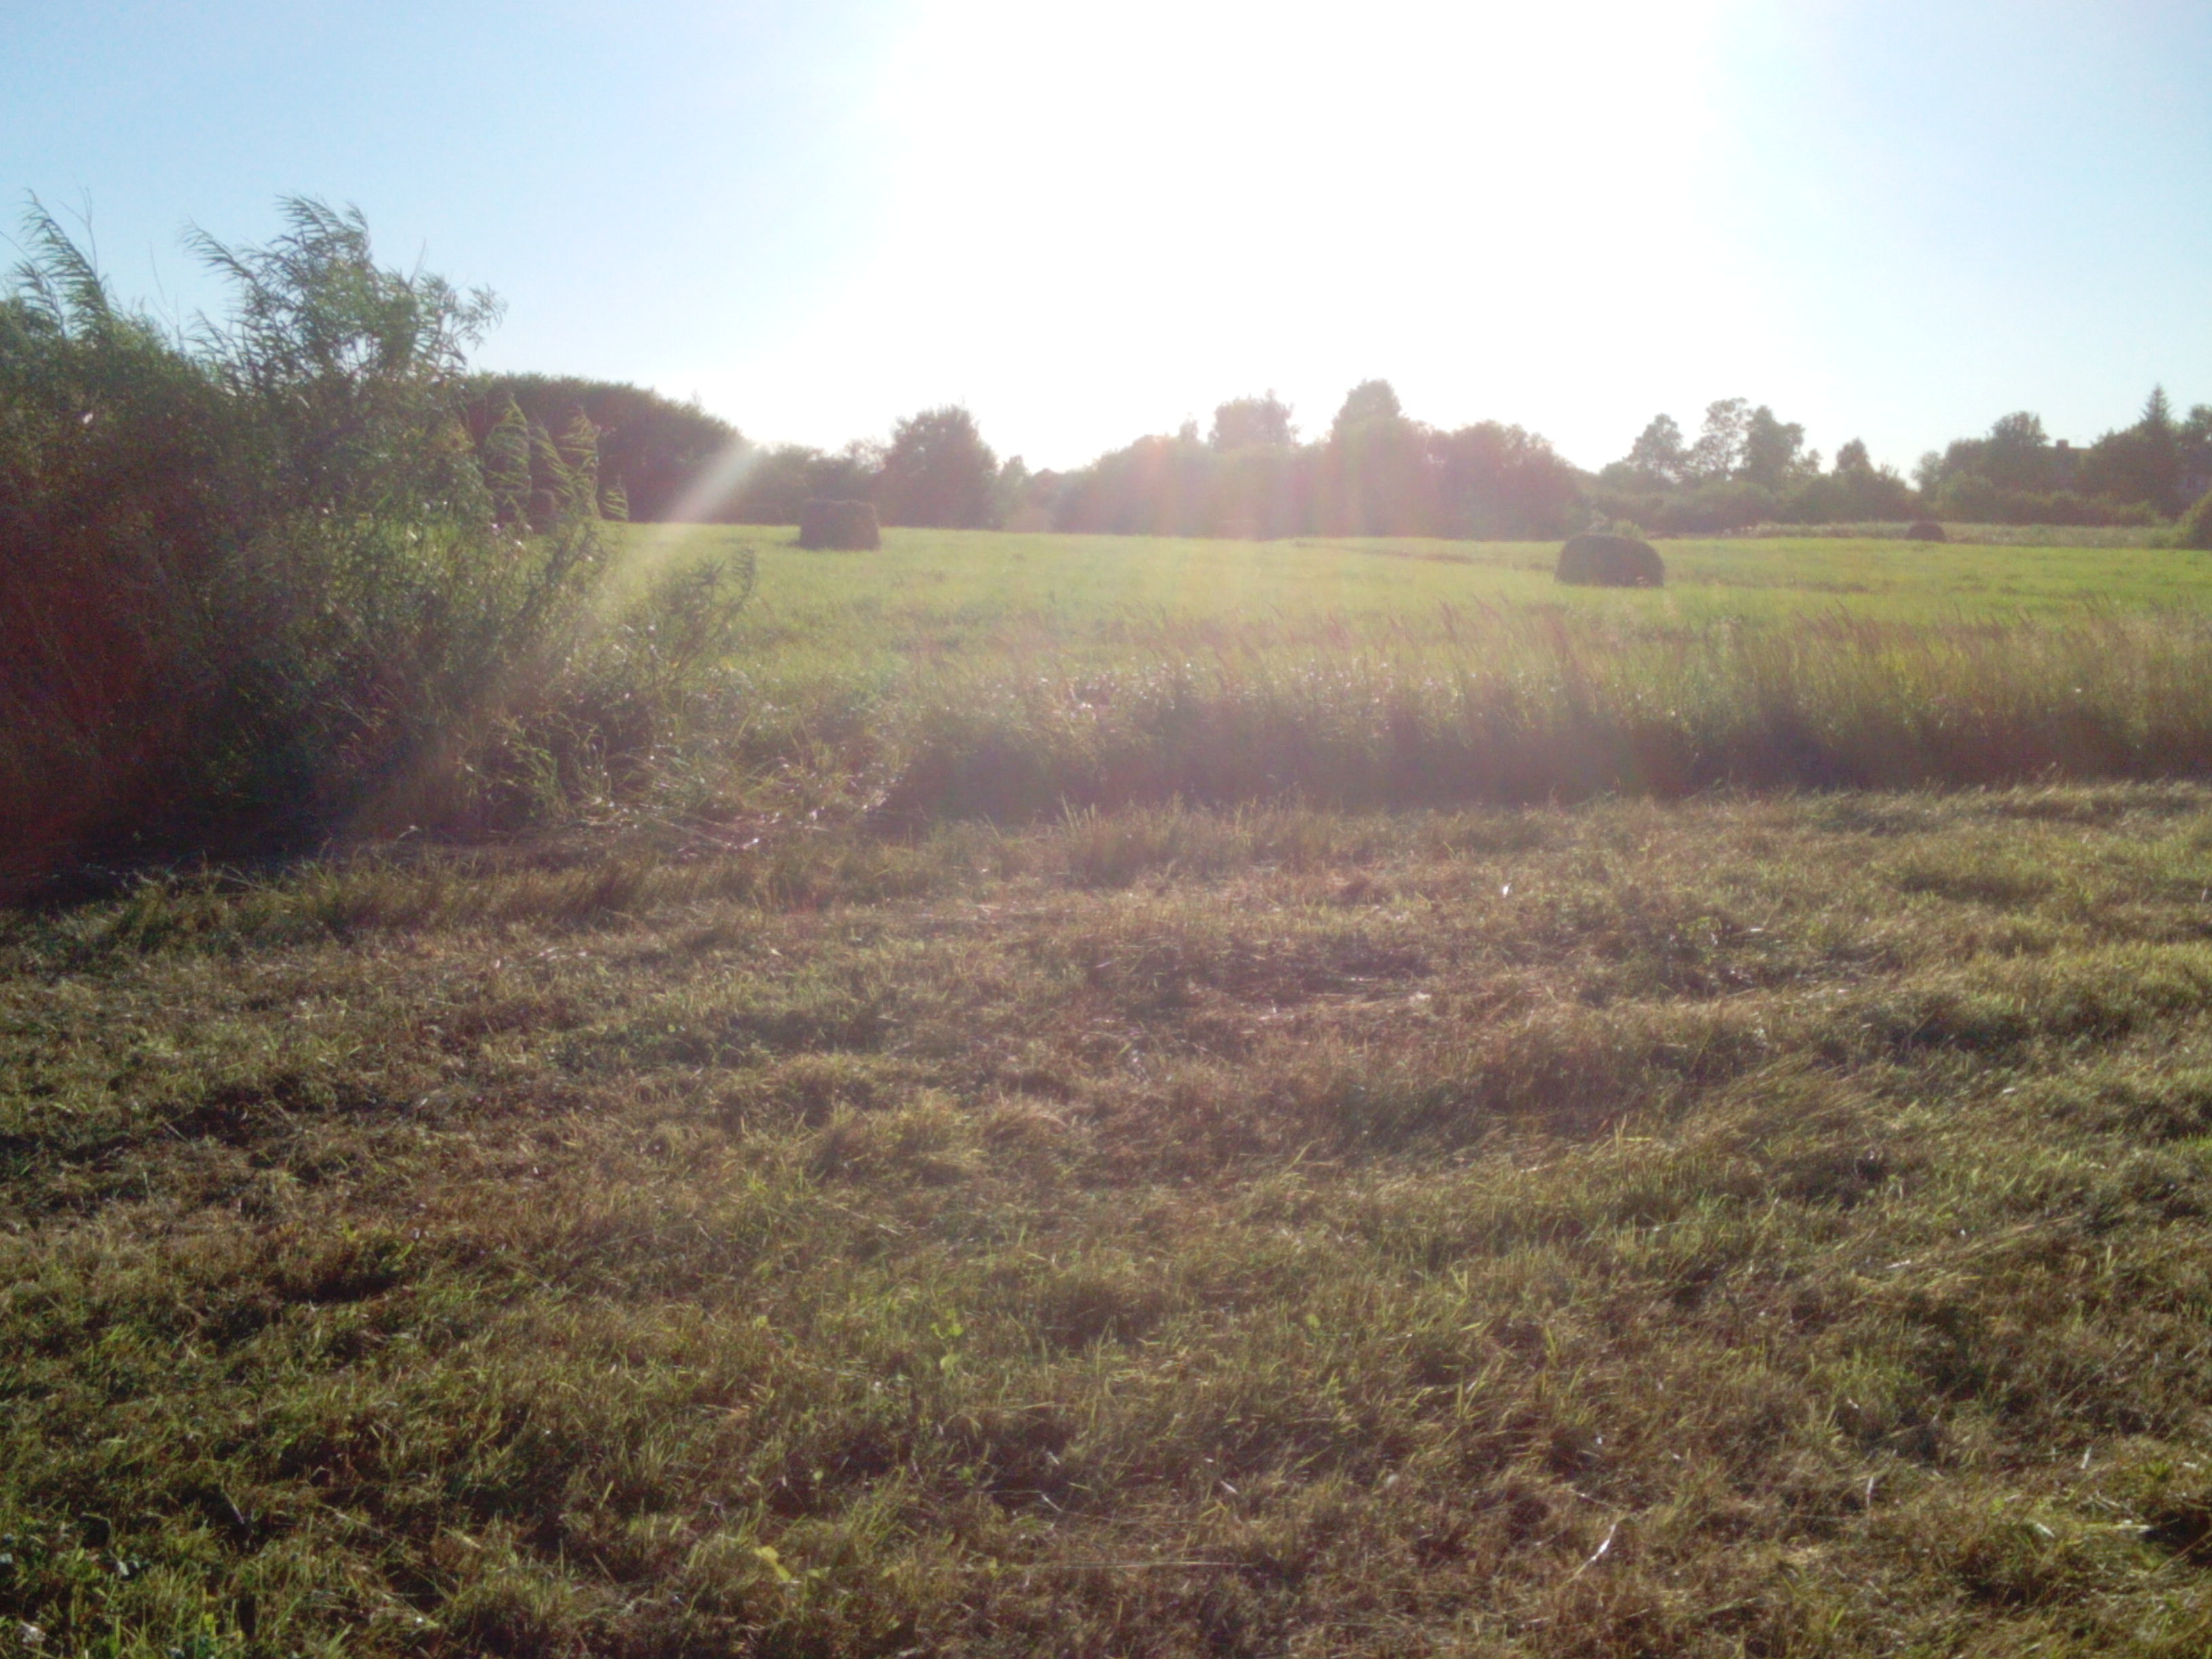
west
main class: Grassland
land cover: Grassland without tree/shrub cover
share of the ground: > 75 %
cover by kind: herbaceous plants 100 %
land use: Agriculture (excluding fallow land and kitchen gardens)
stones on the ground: < 10 %
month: August
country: LV
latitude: 56.5523
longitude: 21.3790
